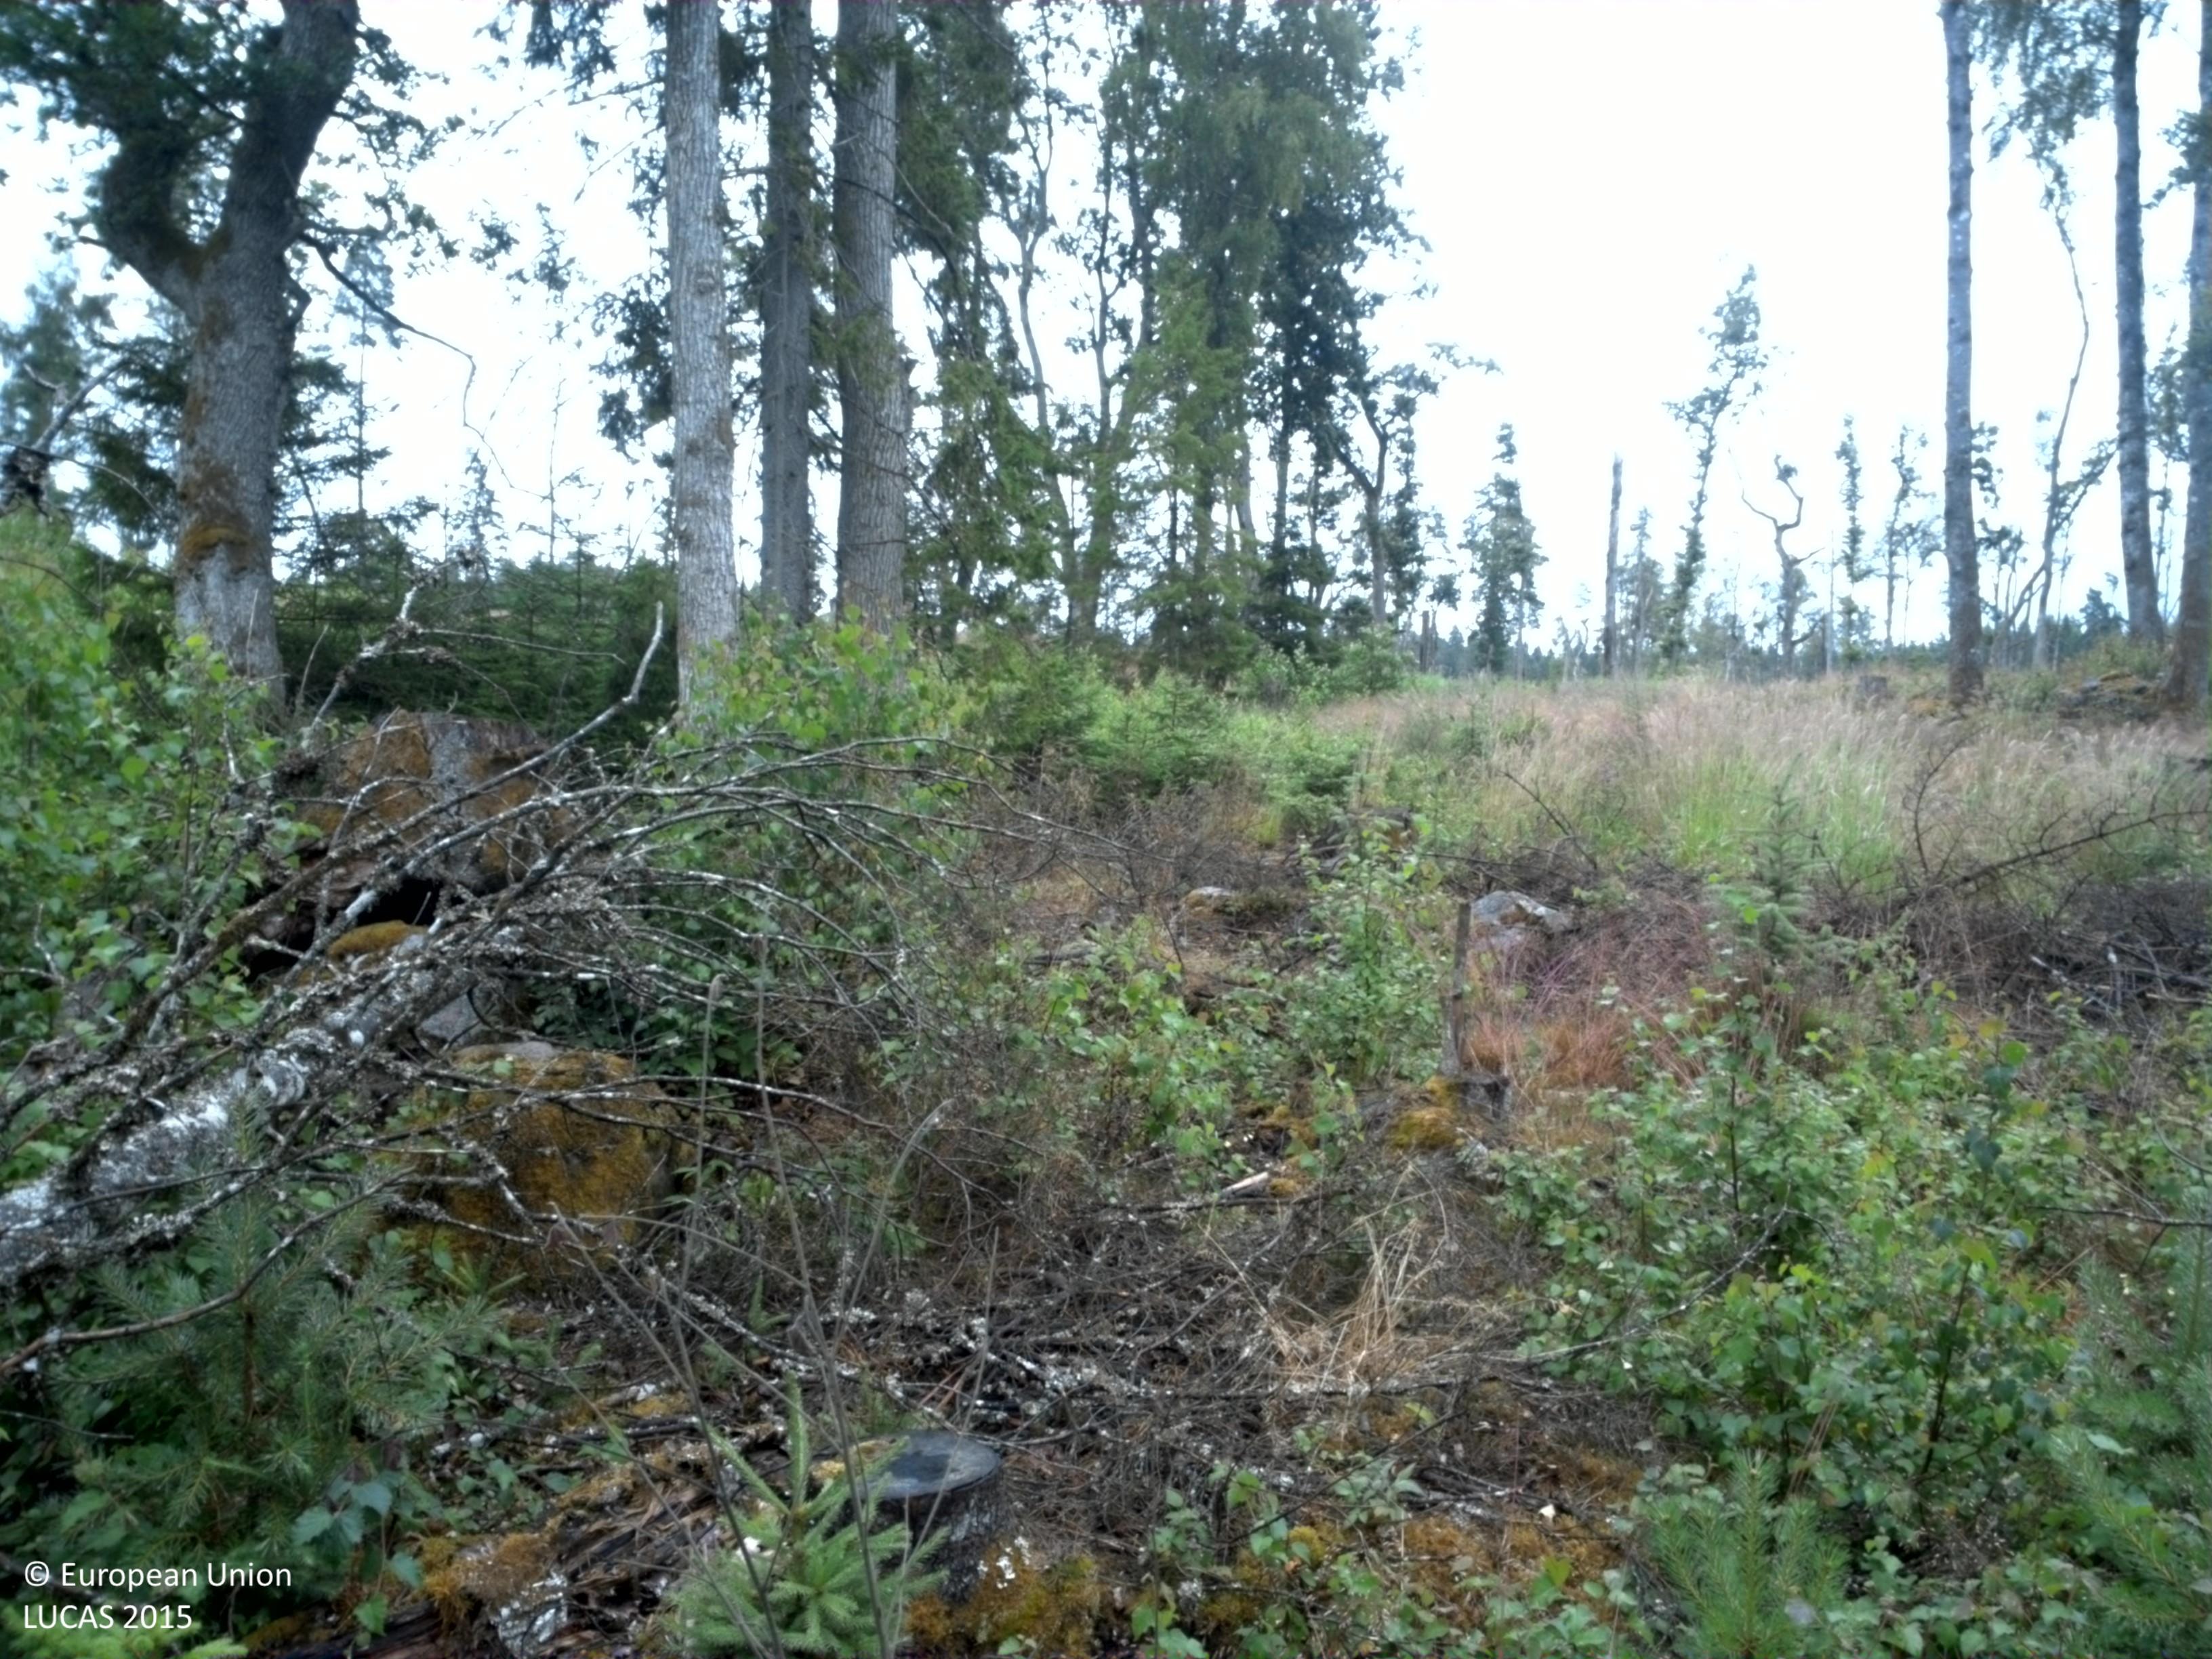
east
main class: Woodland
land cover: Broadleaved woodland
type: hemiboreal forest and nemoral coniferous forest and mixed broadleaved-coniferous forest
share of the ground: > 75 %
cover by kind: broadleaved forest trees 90 %, herbaceous plants 10 %
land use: Forestry
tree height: > 5 m
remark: Clear cut
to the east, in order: Broadleaved woodland; Ditches and canals; Inland marshes; Broadleaved woodland; Grassland with sparse tree/shrub cover; Broadleaved woodland; Grassland with sparse tree/shrub cover
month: July
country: SE
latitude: 58.3037
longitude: 13.3559
